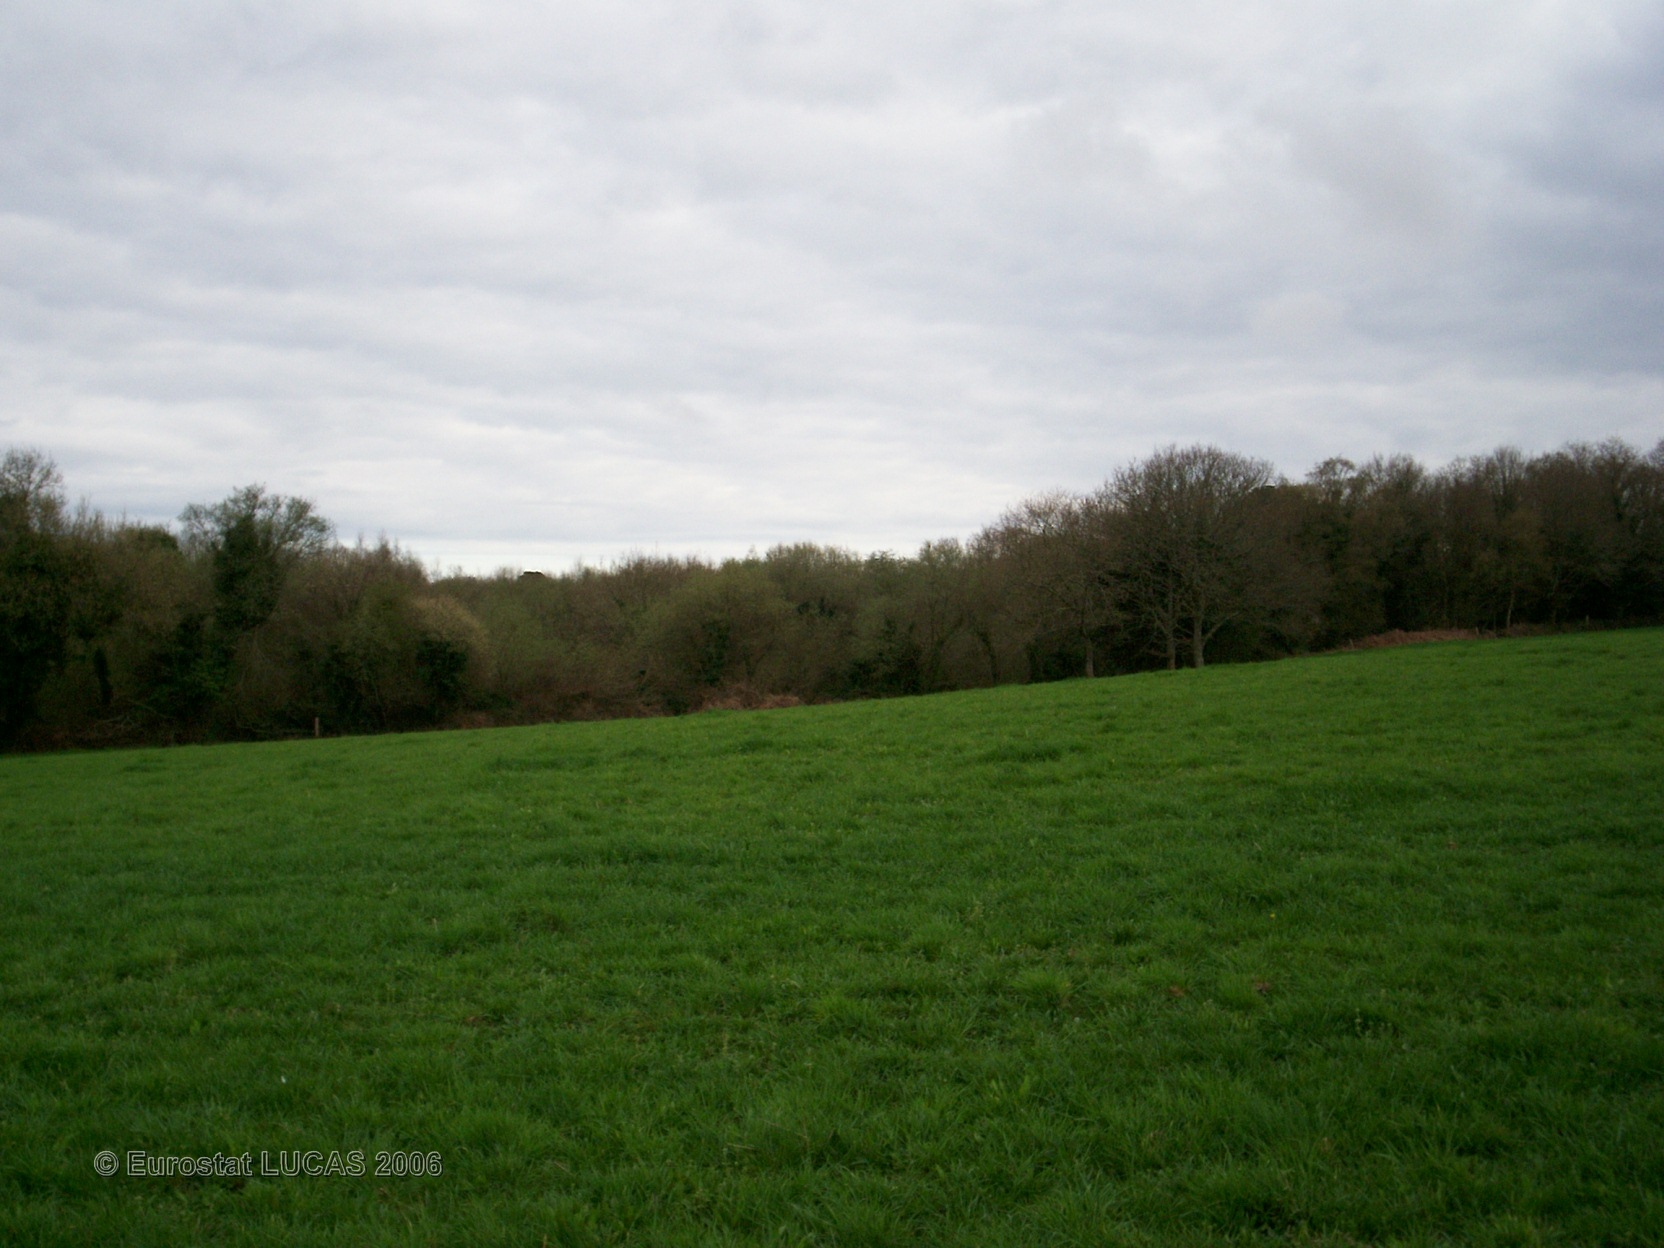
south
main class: Grassland
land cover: Grassland without tree/shrub cover
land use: Agriculture (excluding fallow land and kitchen gardens)
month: April
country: FR
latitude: 47.8085
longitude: -3.4957
